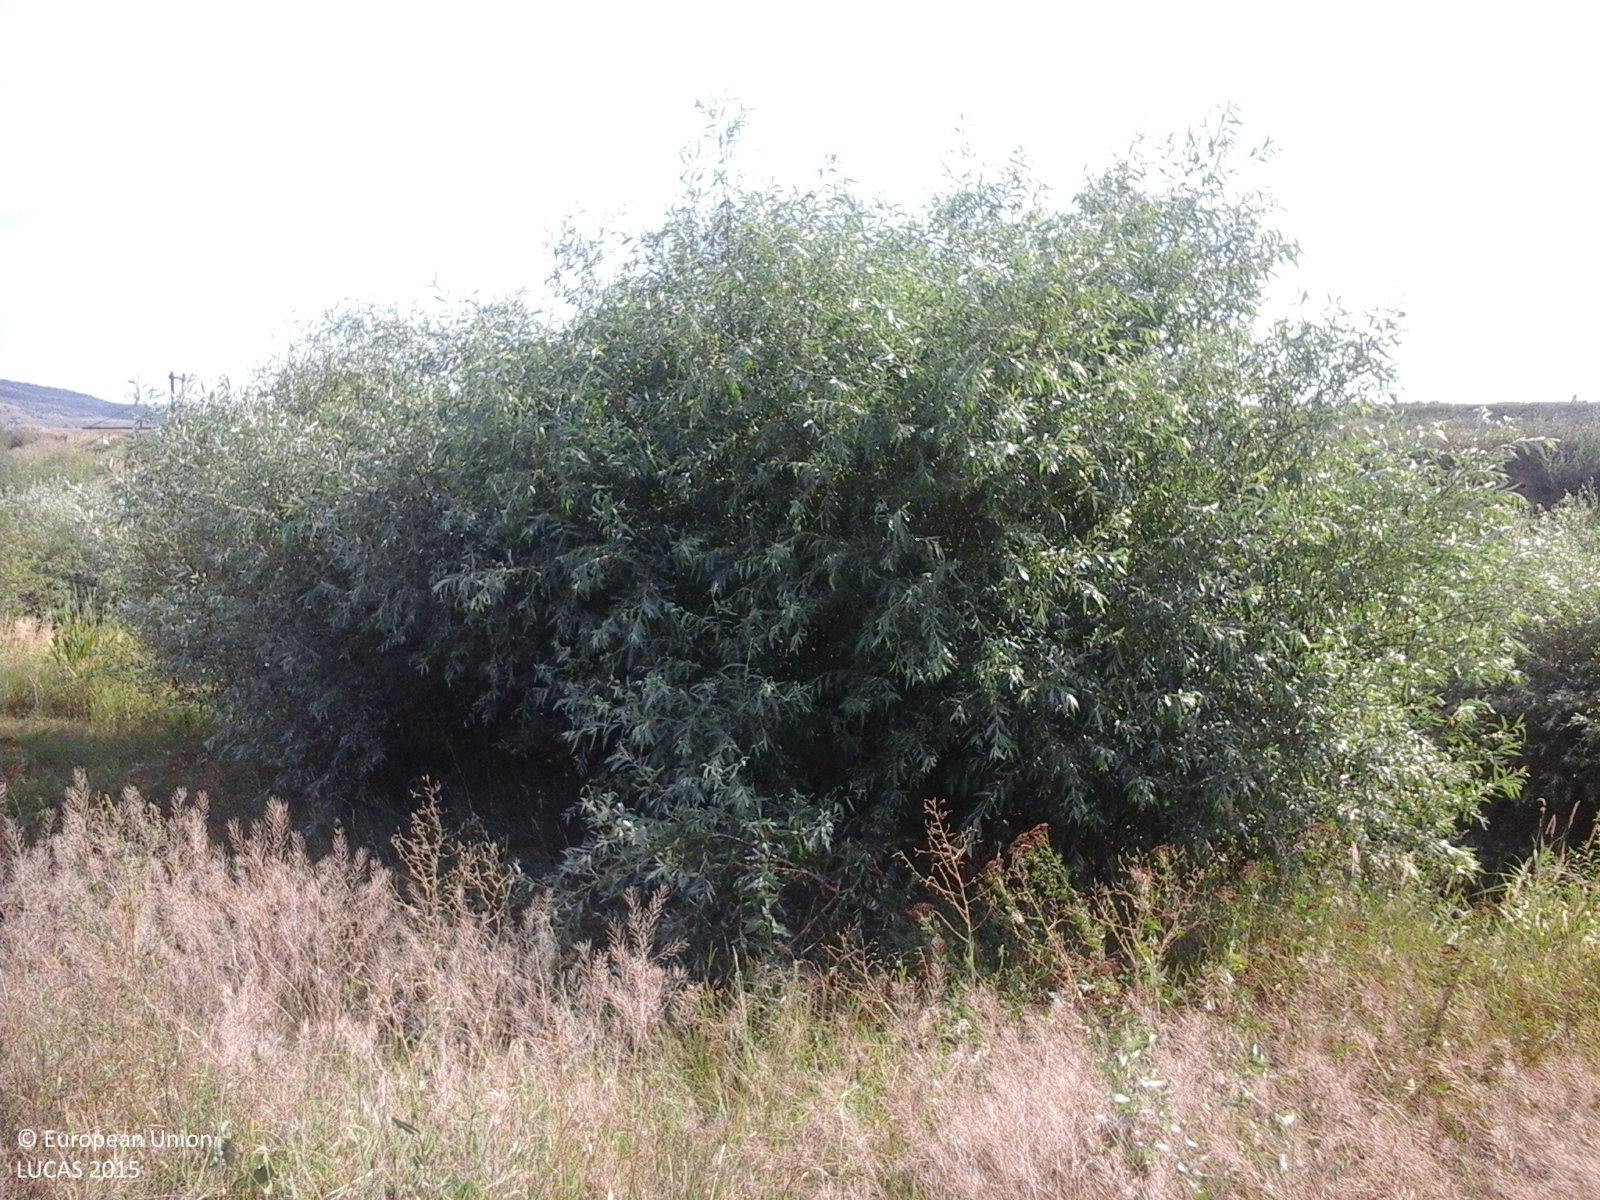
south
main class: Grassland
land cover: Grassland without tree/shrub cover
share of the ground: > 75 %
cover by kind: herbaceous plants 100 %
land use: Agriculture (excluding fallow land and kitchen gardens)
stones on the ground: < 10 %
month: July
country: RO
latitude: 46.3396
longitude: 27.7742
